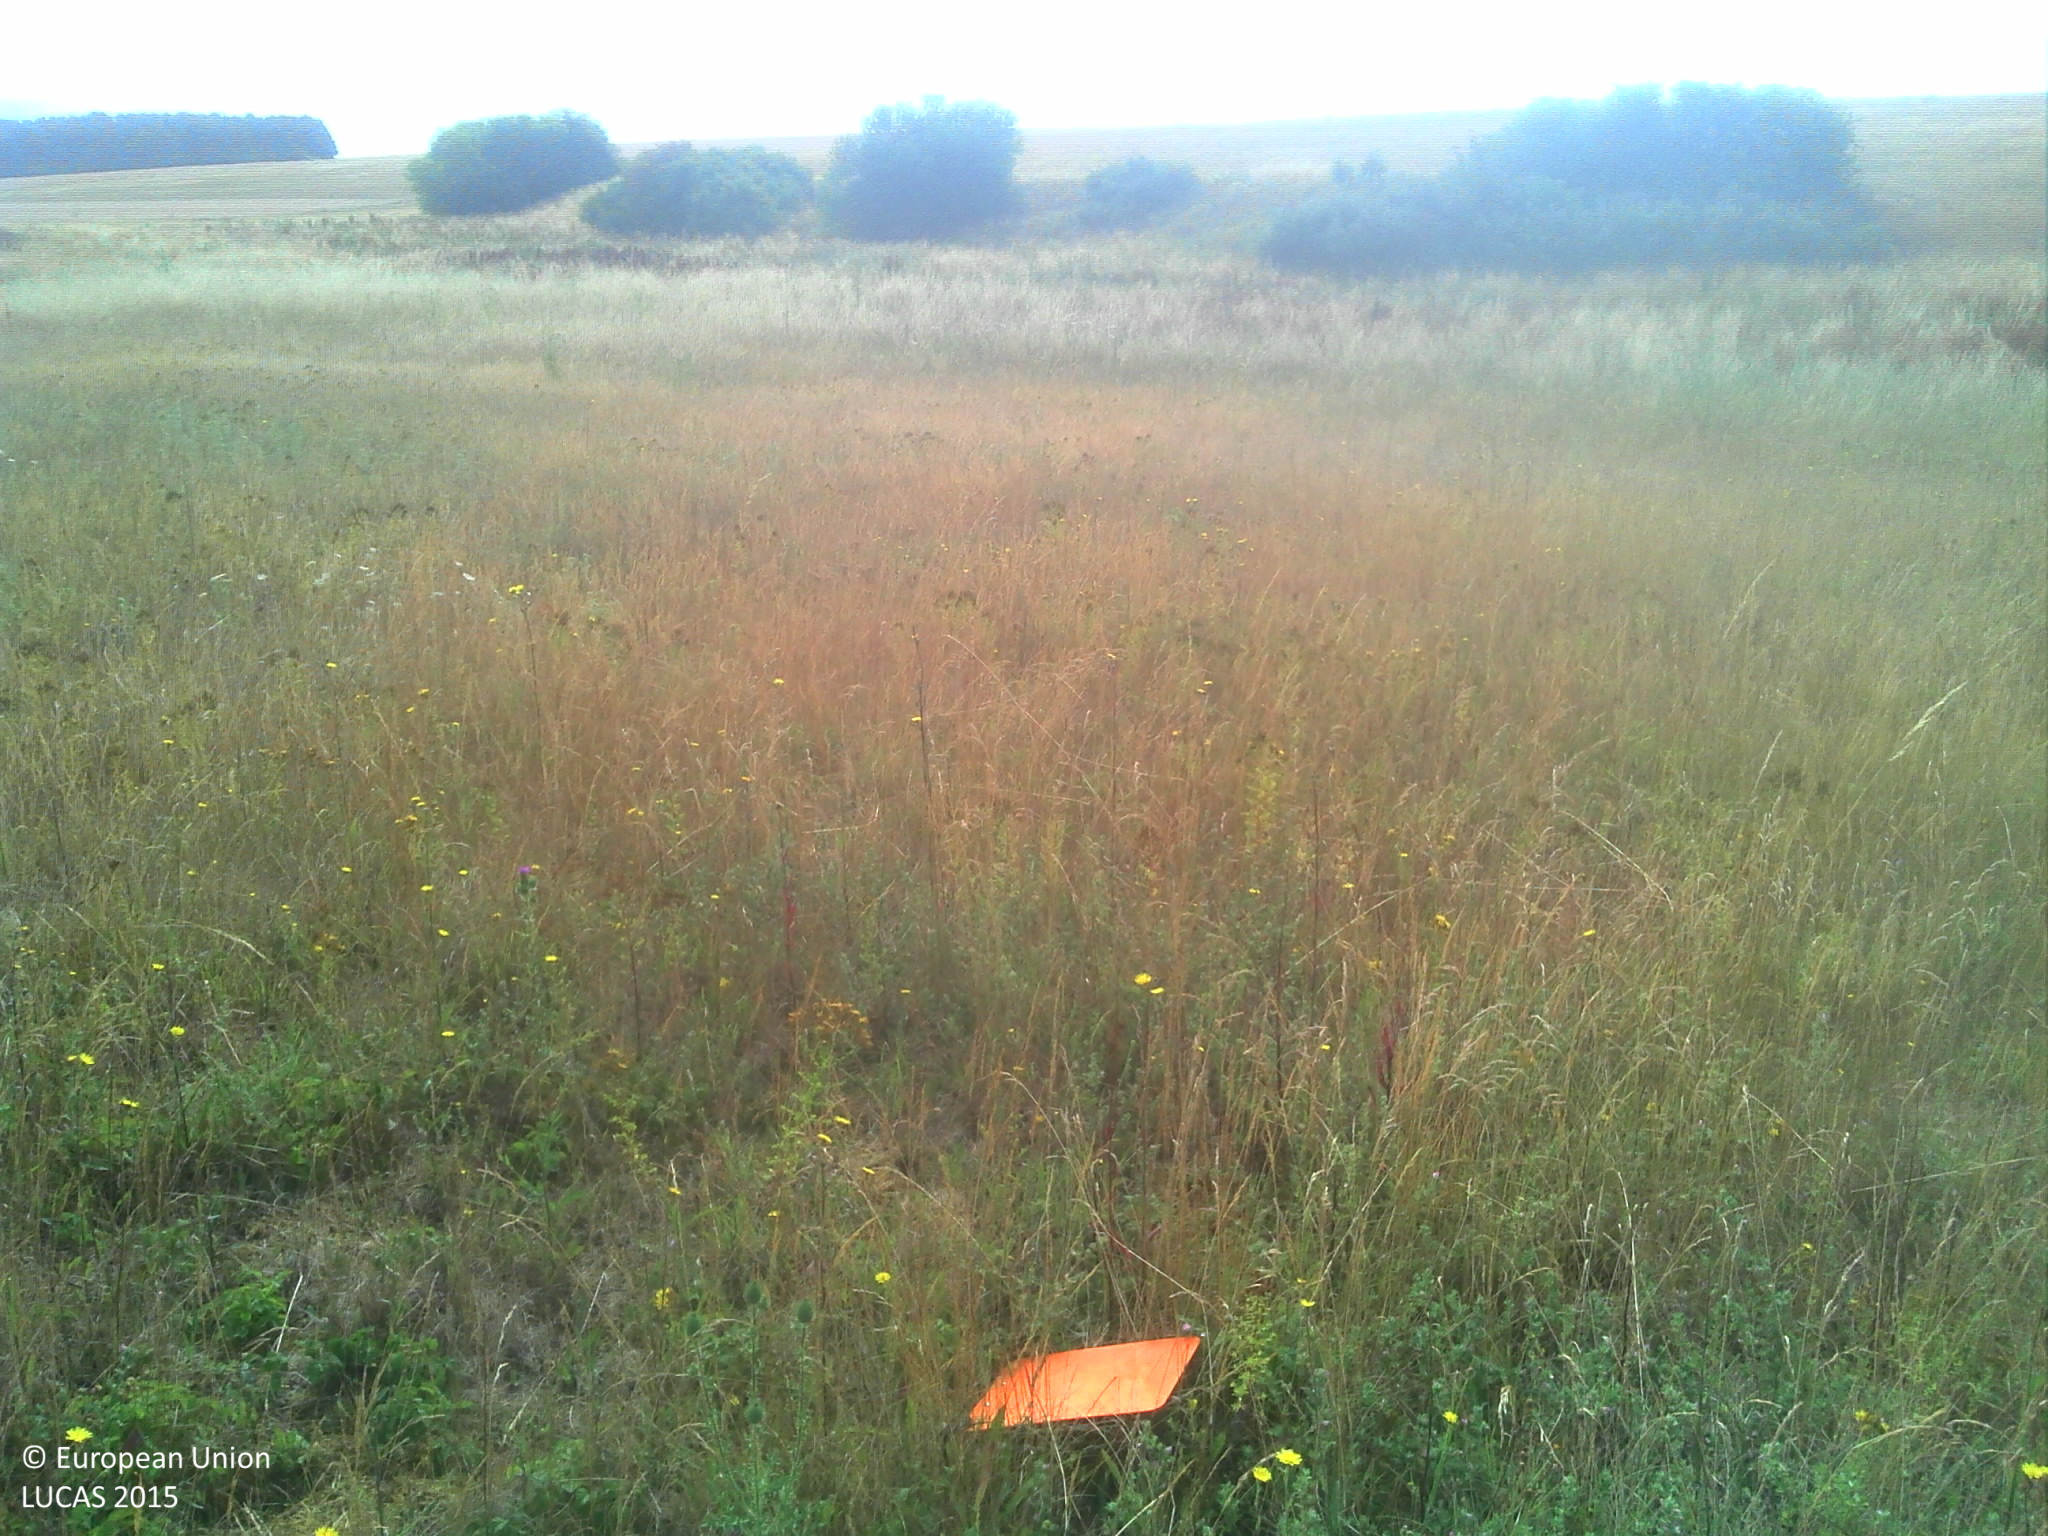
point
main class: Grassland
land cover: Grassland without tree/shrub cover
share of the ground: > 75 %
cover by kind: herbaceous plants 100 %
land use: Agriculture (excluding fallow land and kitchen gardens)
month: July
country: FR
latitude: 47.7923
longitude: 1.3471
